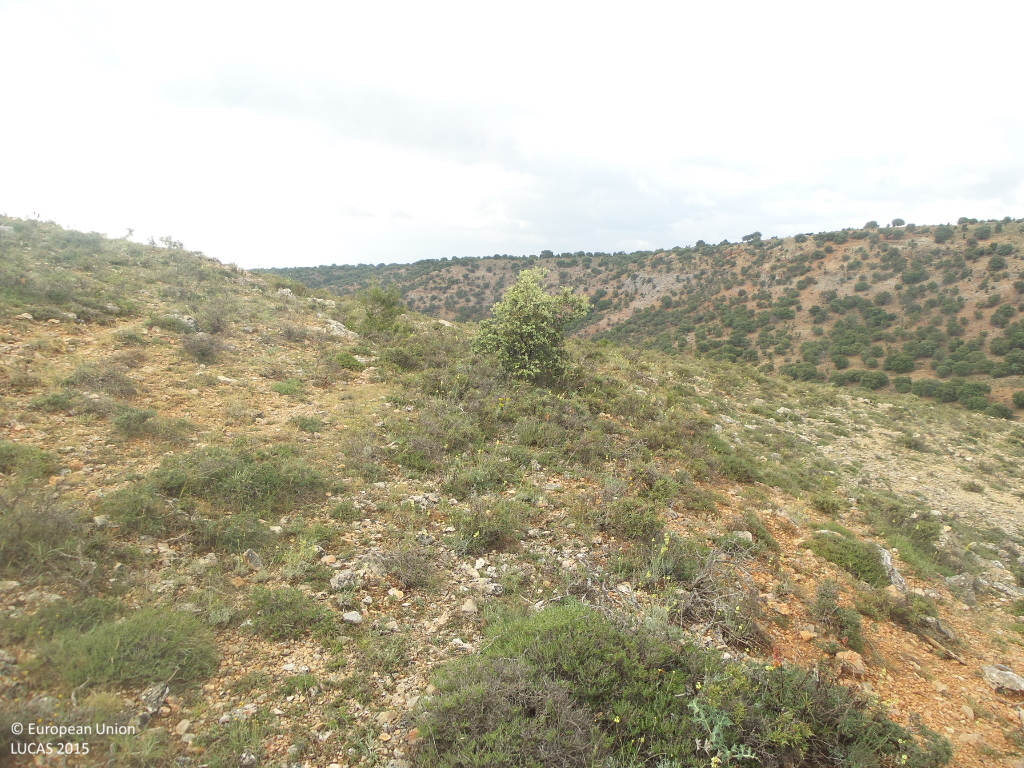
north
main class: Shrubland
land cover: Shrubland with sparse tree cover
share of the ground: 25 - 50 %
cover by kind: shrubs 45 %, unconsolidated bare surface 30 %, consolidated bare surface 20 %, broadleaved forest trees 5 %
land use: Semi-natural and natural areas not in use
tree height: < 5 m
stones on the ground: 25 - 50 %
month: June
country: ES
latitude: 41.3565
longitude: -3.1302
